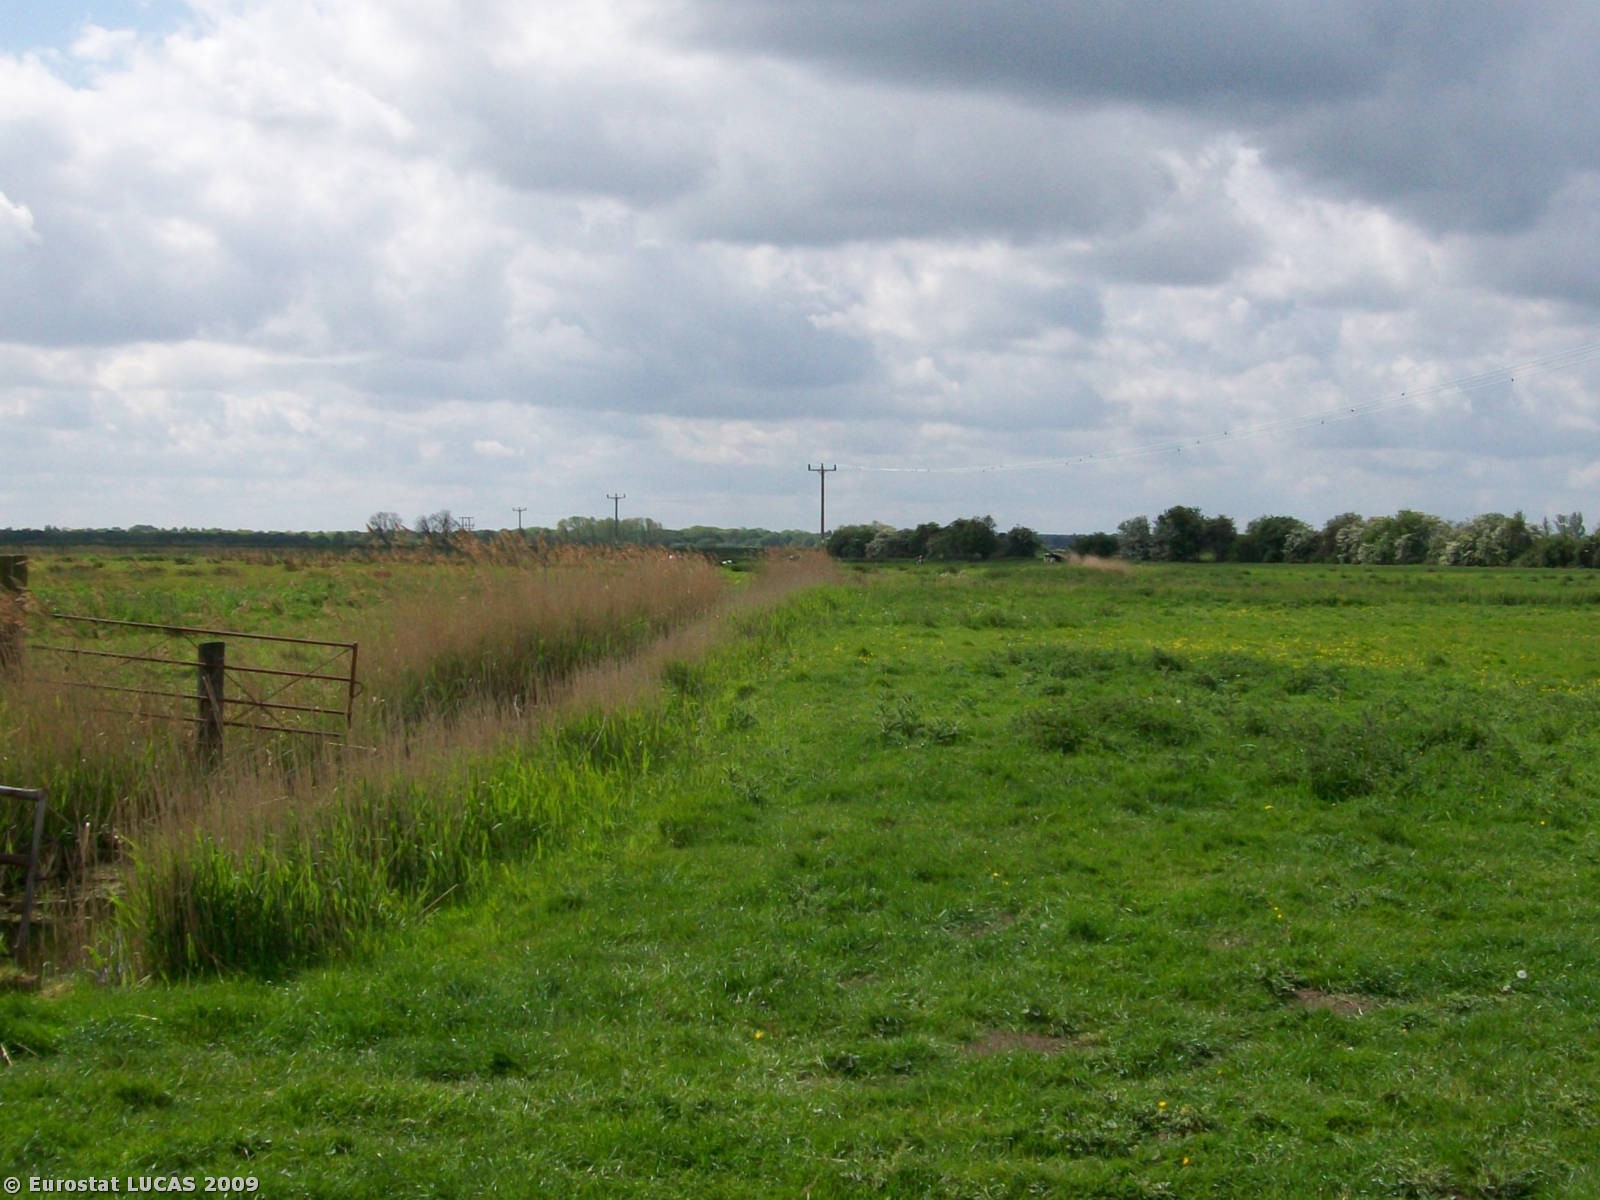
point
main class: Grassland
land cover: Grassland without tree/shrub cover
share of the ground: > 75 %
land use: Agriculture (excluding fallow land and kitchen gardens)
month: May
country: GB
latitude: 52.6893
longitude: 1.5336
